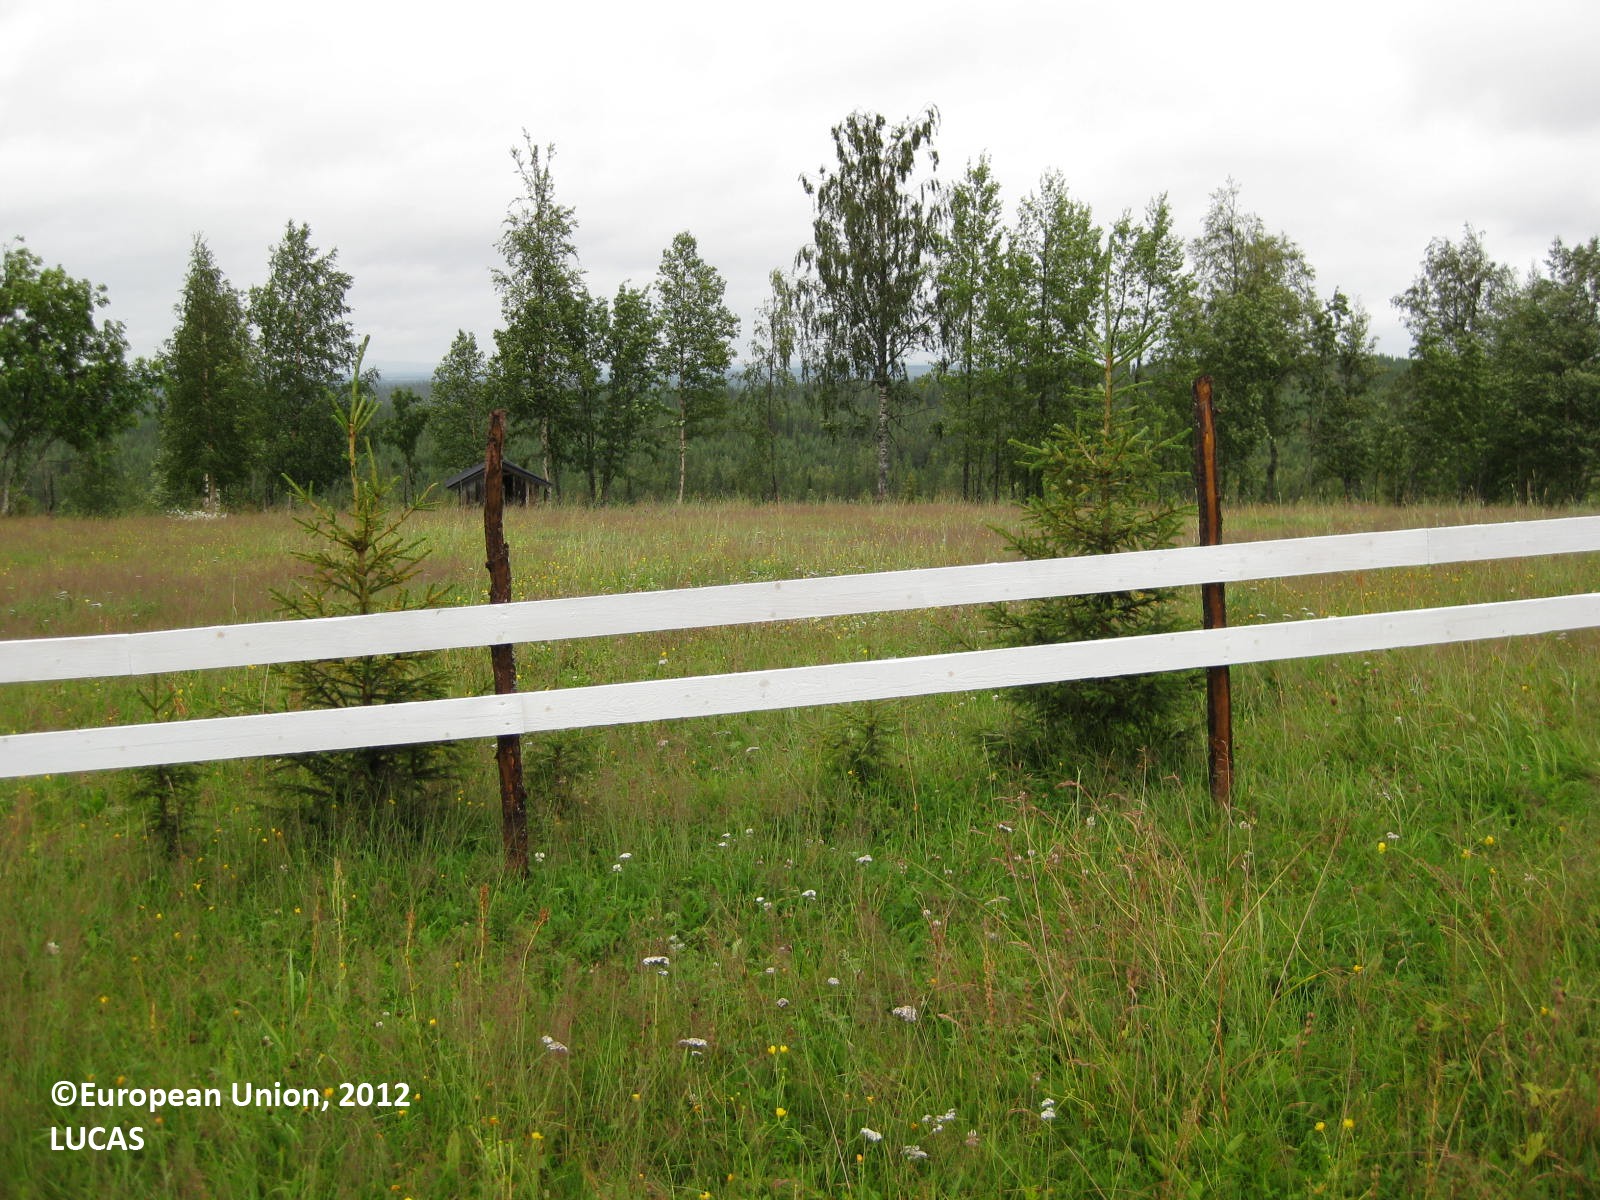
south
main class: Grassland
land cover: Grassland without tree/shrub cover
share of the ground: > 75 %
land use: Residential
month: August
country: FI
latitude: 65.9679
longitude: 28.1658
